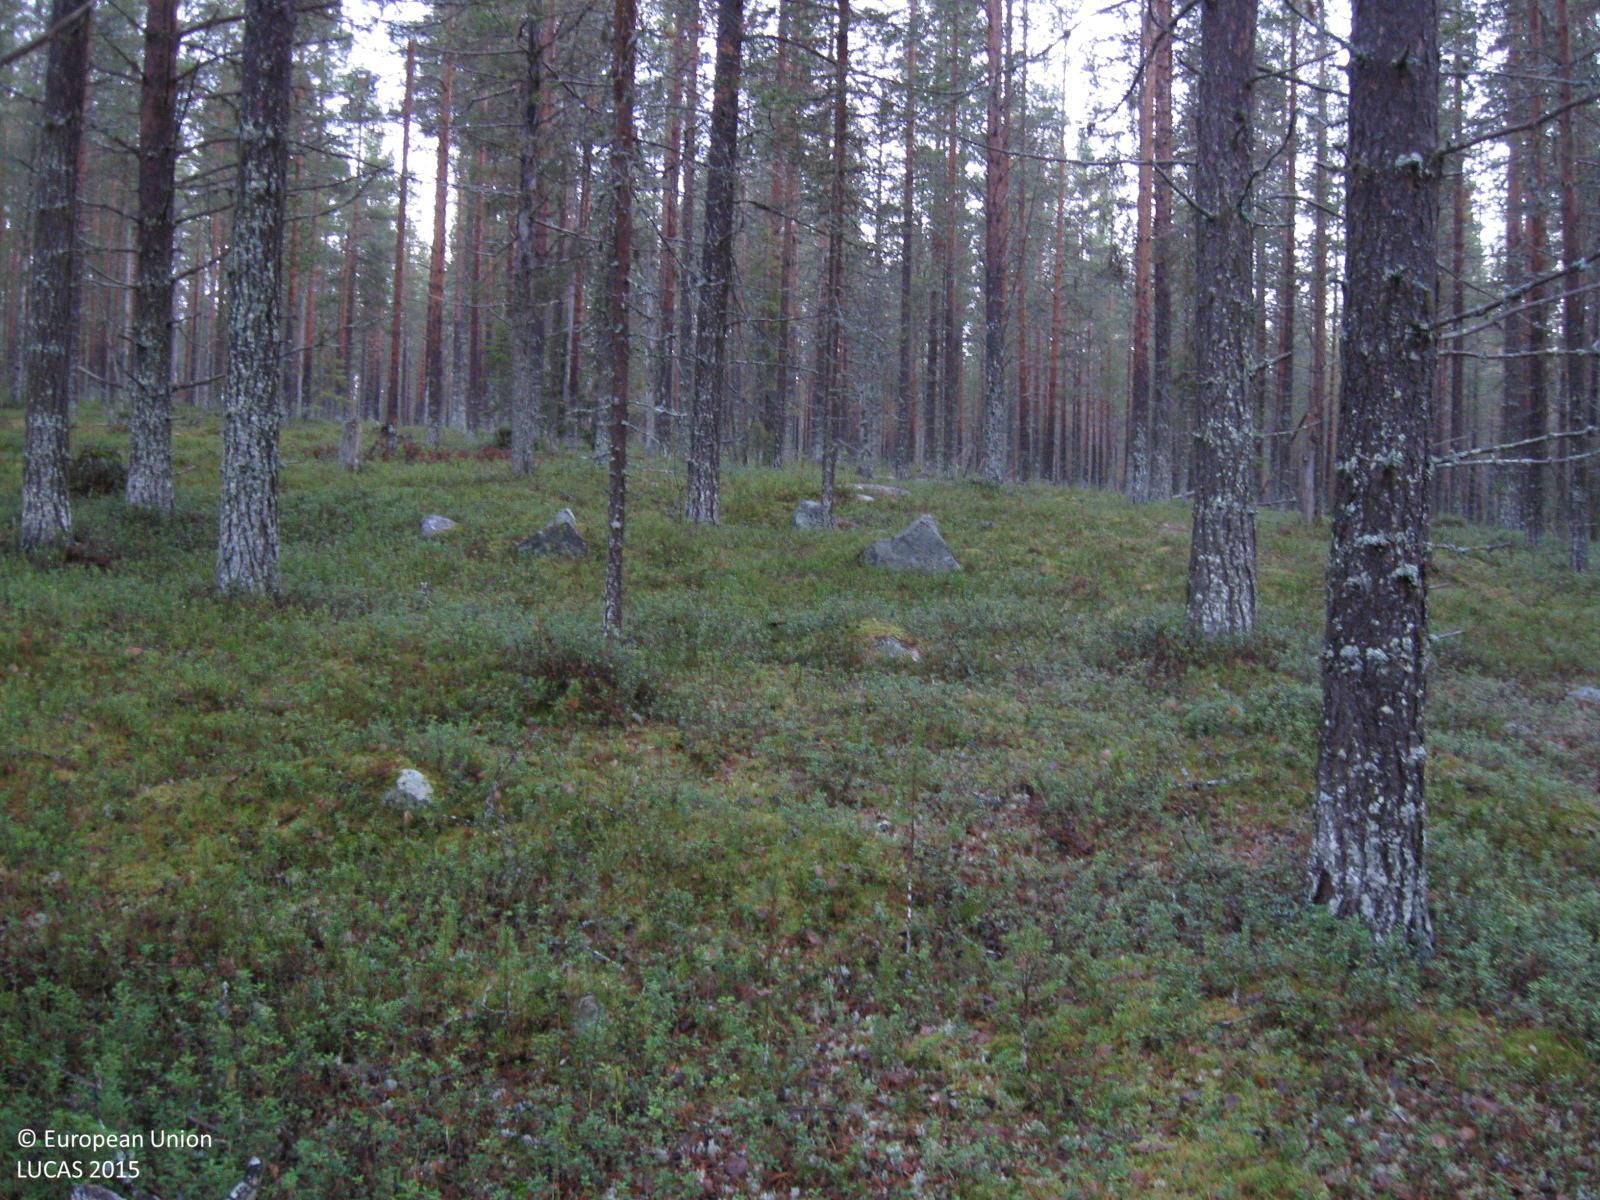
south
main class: Woodland
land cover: Pine dominated coniferous woodland
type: boreal forest
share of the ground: > 75 %
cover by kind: coniferous forest trees 75 %, shrubs 10 %, lichens and mosses 10 %, herbaceous plants 5 %
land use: Forestry
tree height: > 5 m
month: October
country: SE
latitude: 66.4548
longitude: 20.8838
